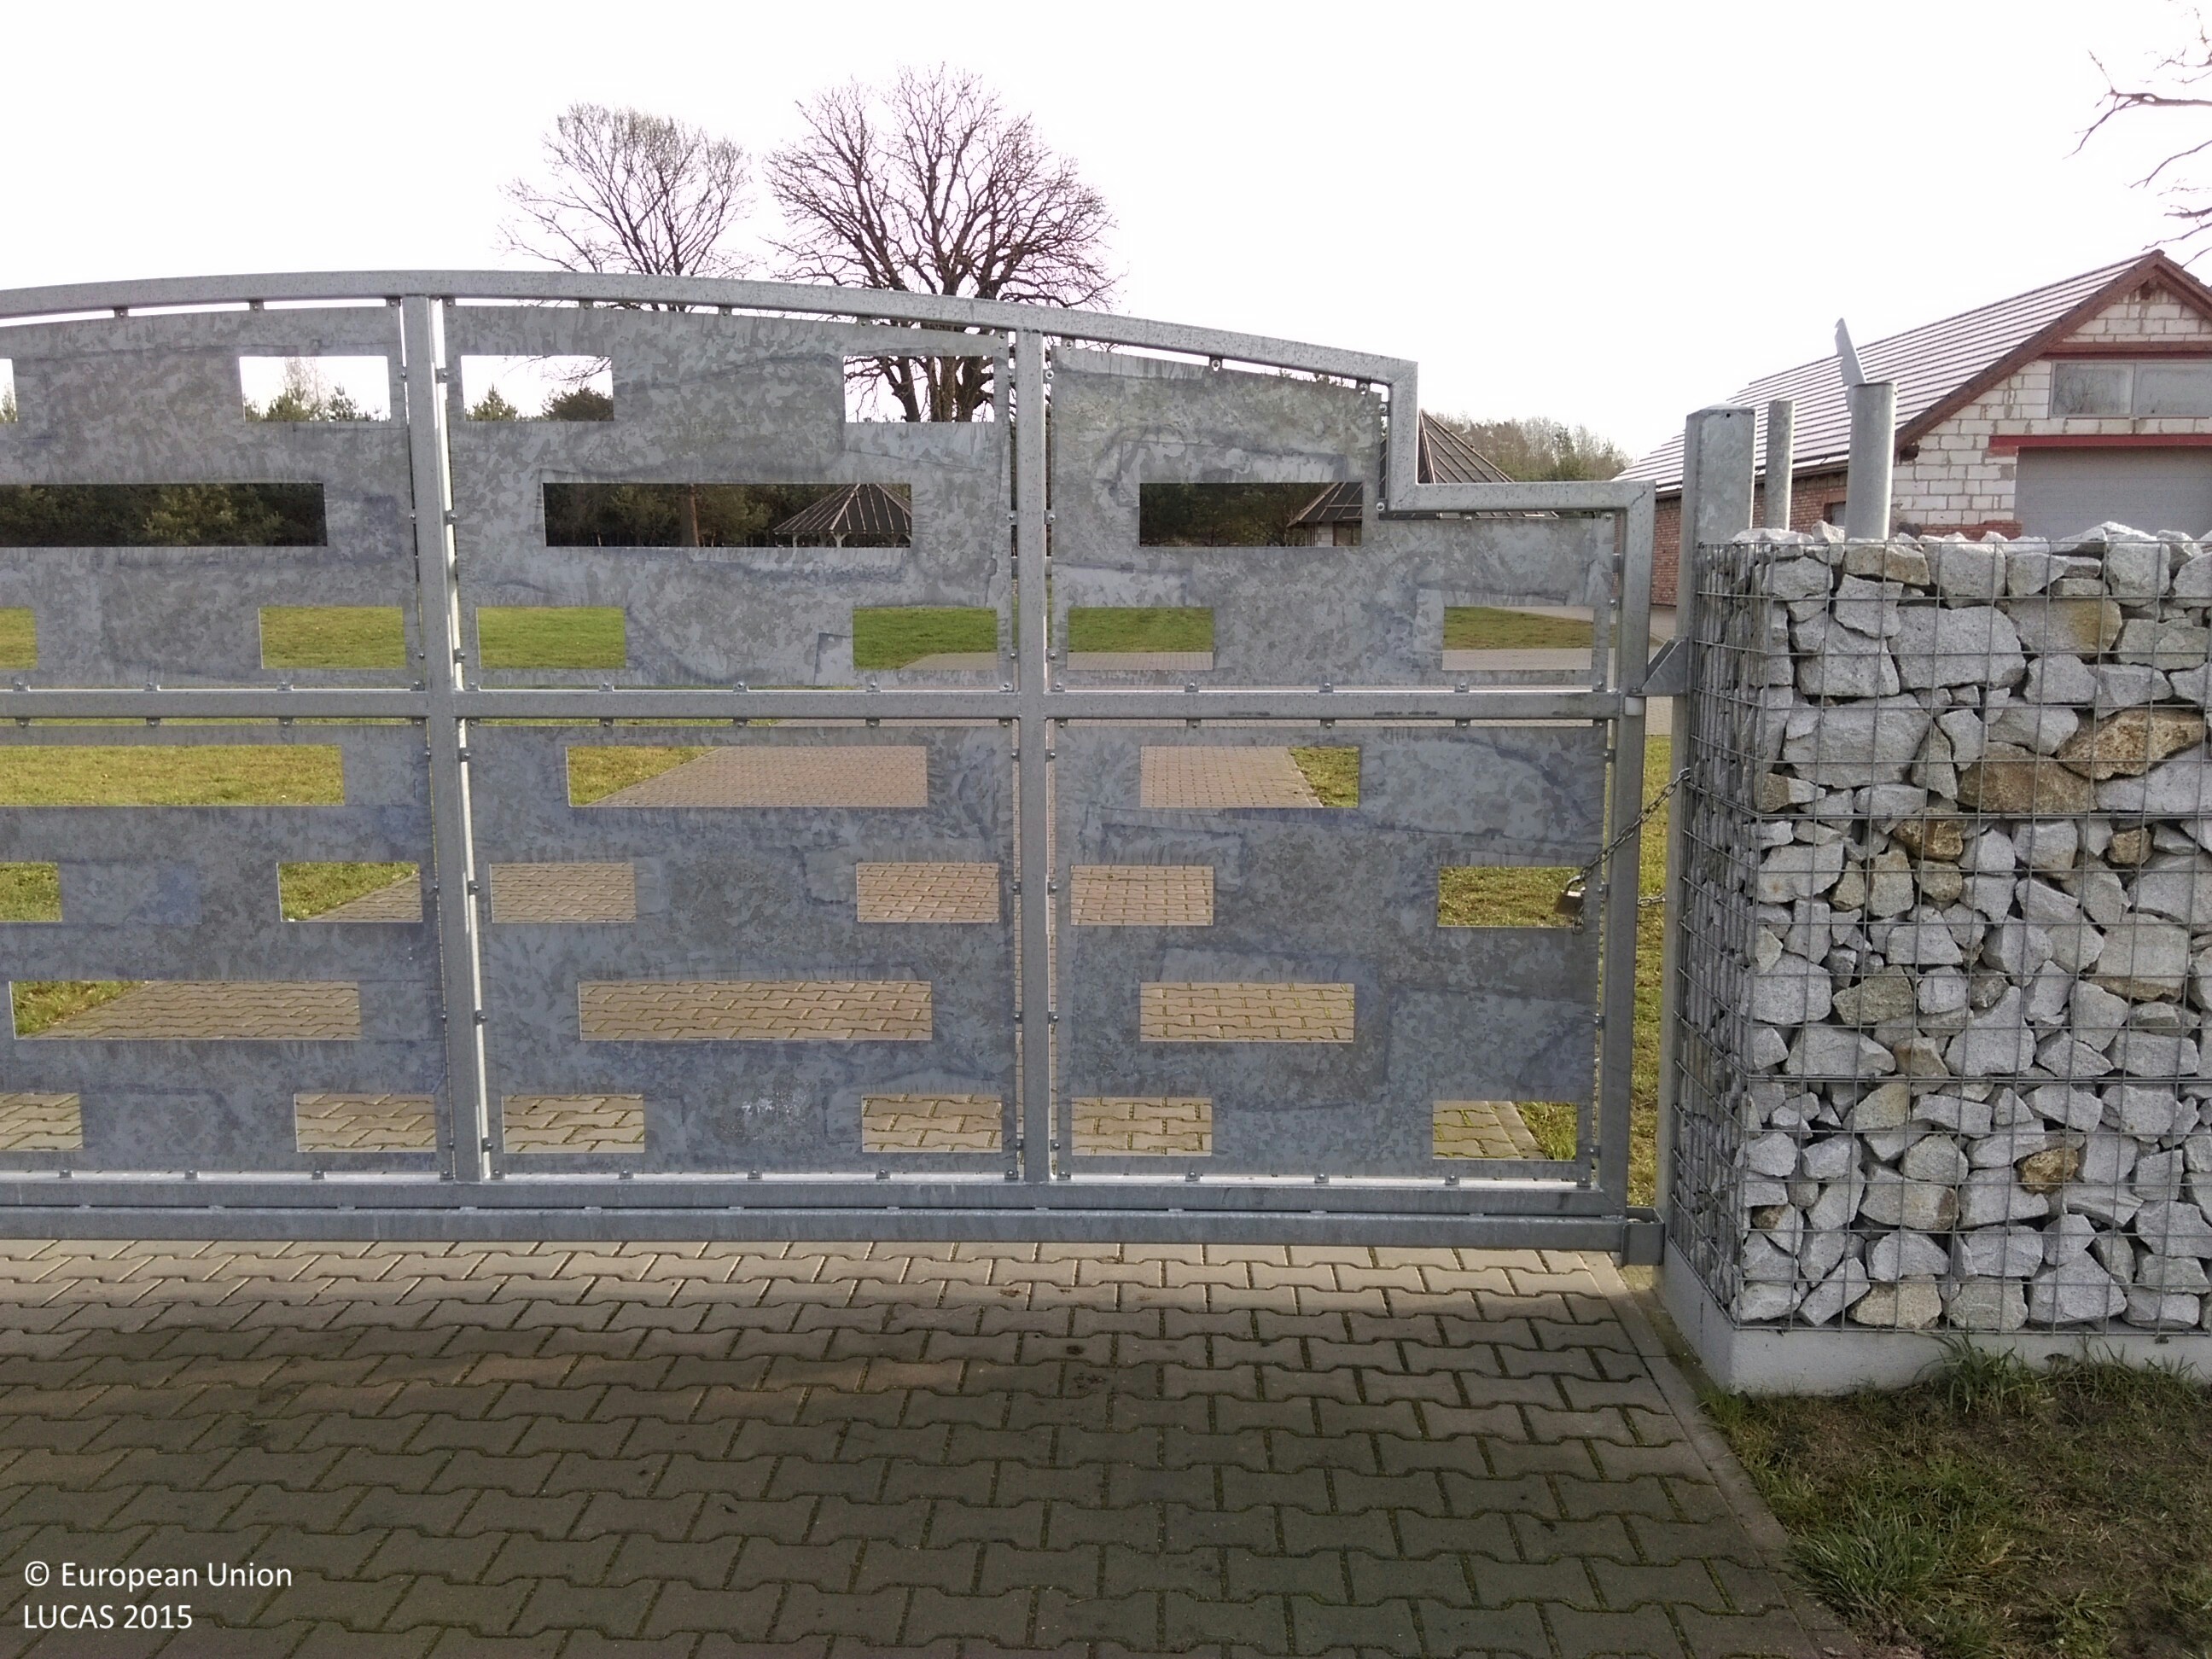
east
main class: Grassland
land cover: Grassland without tree/shrub cover
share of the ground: > 75 %
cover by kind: herbaceous plants 100 %
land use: Residential
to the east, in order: Grassland without tree/shrub cover; Grassland with sparse tree/shrub cover; Fences; Pine dominated coniferous woodland; Tracks; Pine dominated coniferous woodland; Spontaneously vegetated surfaces
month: December
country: PL
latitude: 52.2872
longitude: 16.2076
